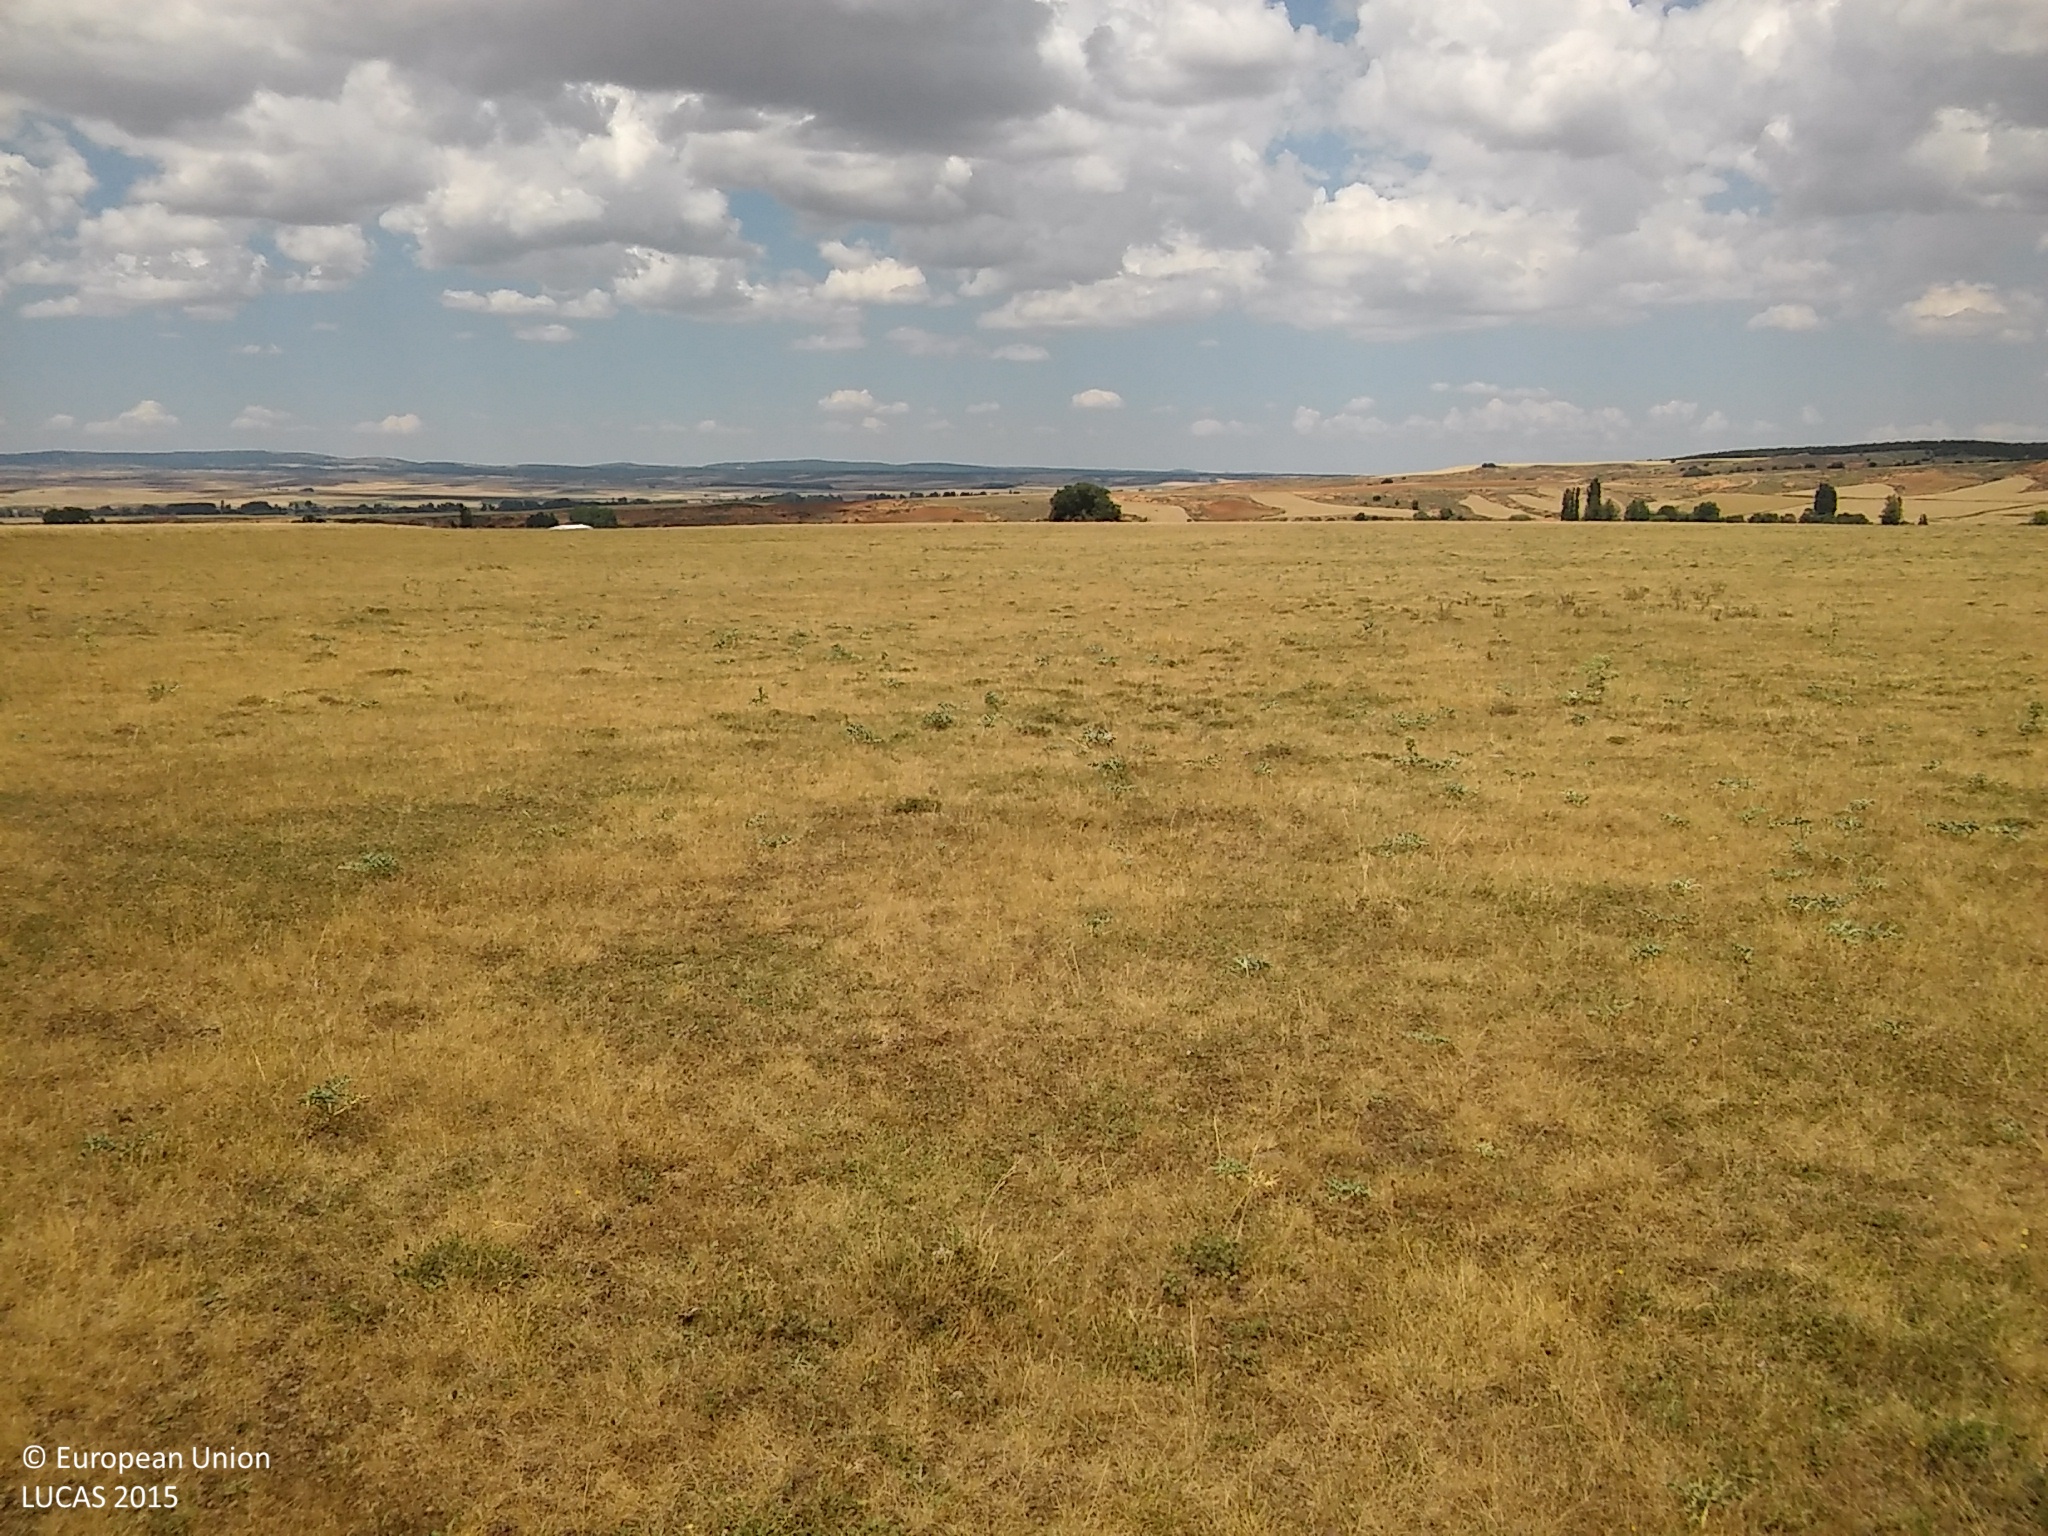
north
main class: Grassland
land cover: Grassland without tree/shrub cover
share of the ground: > 75 %
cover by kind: herbaceous plants 100 %
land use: Agriculture (excluding fallow land and kitchen gardens)
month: June
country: ES
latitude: 41.2863
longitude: -3.6476
